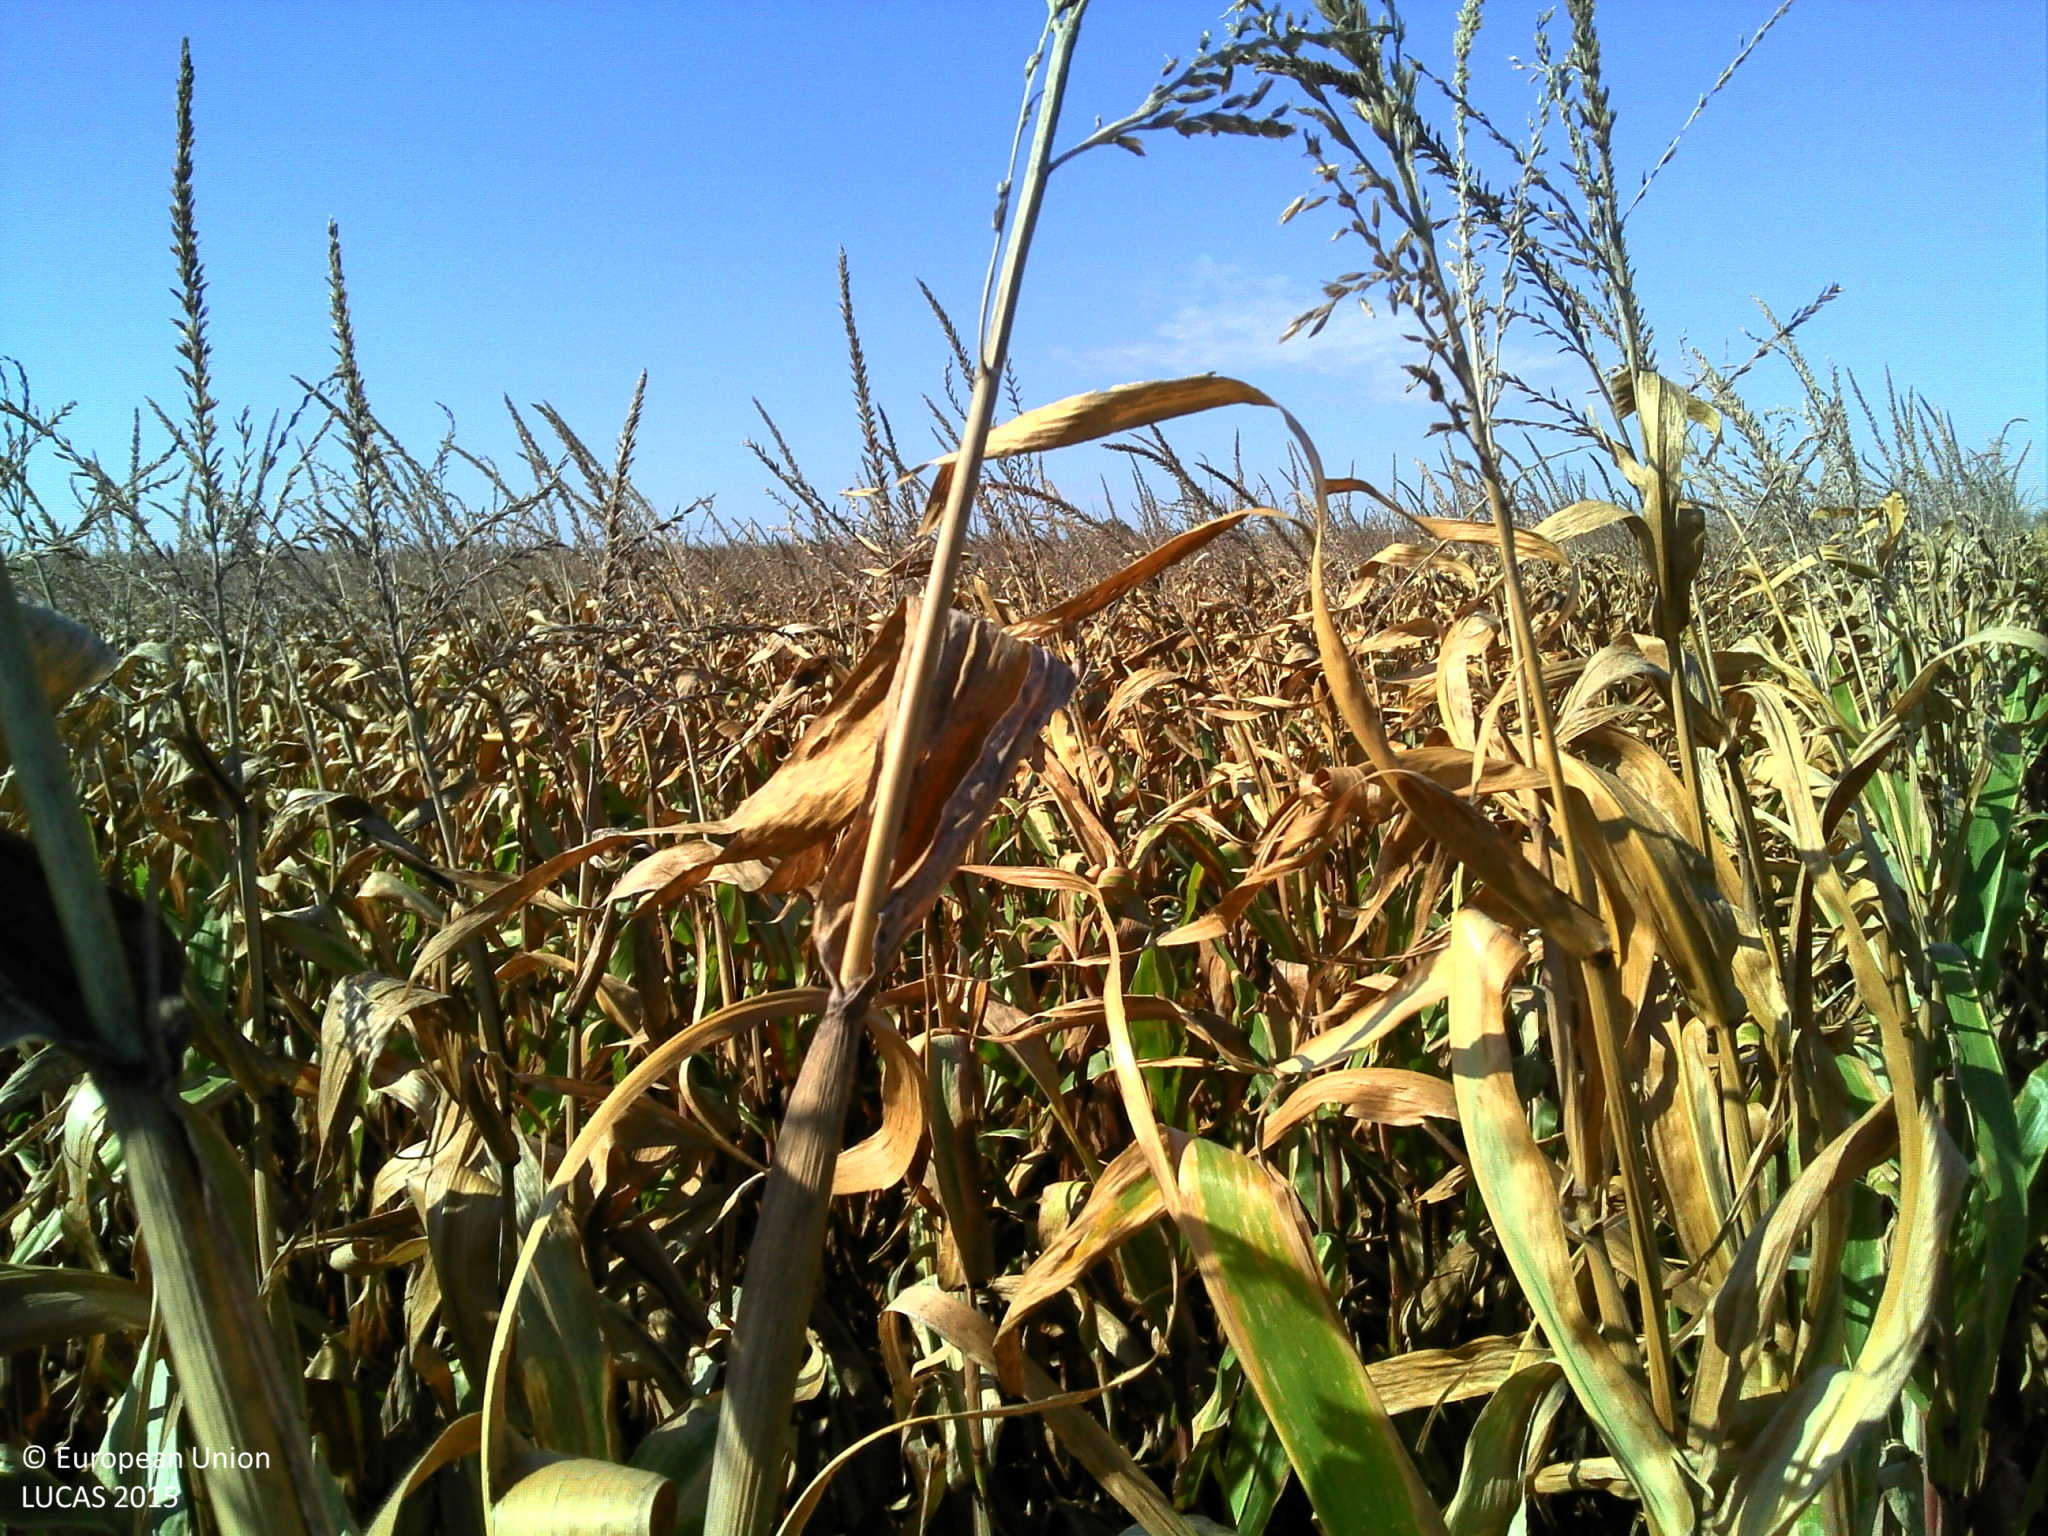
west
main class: Cropland
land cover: Maize
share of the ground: > 75 %
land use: Agriculture (excluding fallow land and kitchen gardens)
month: September
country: FR
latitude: 46.4963
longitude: -1.1212
